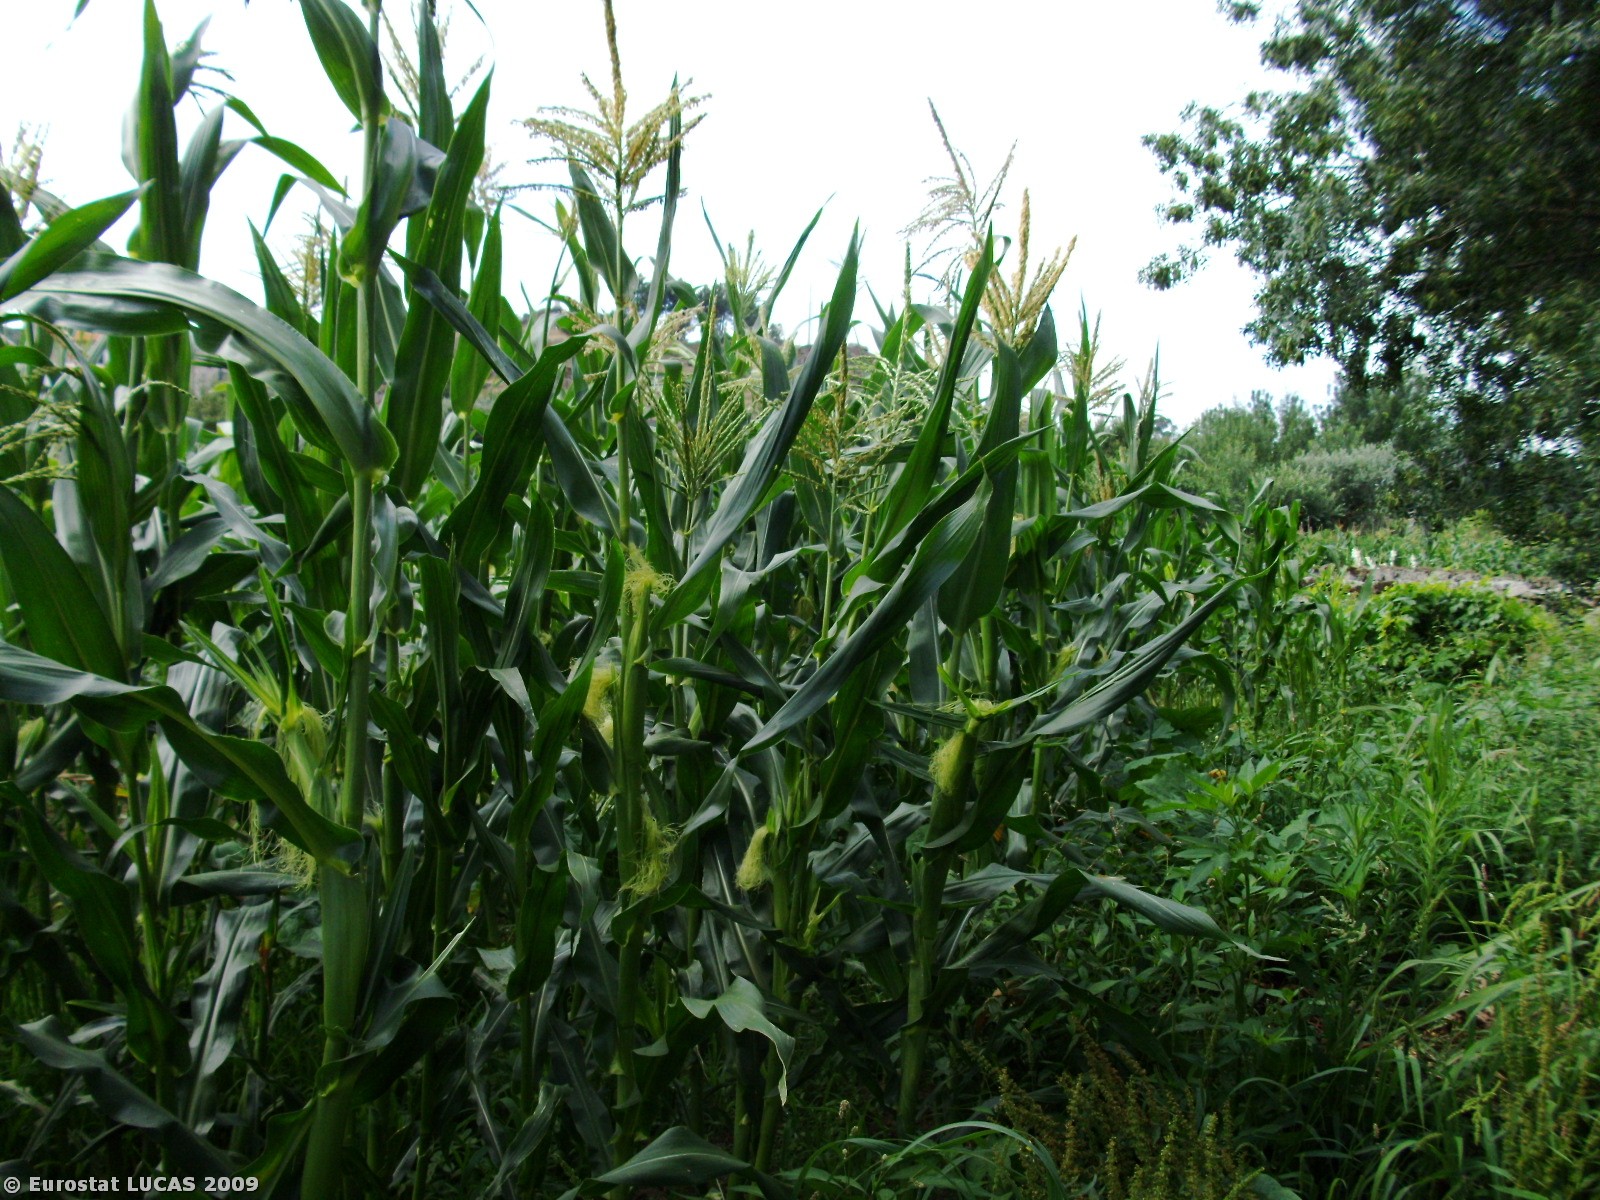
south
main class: Cropland
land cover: Maize
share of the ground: > 75 %
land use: Agriculture (excluding fallow land and kitchen gardens)
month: July
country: PT
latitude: 40.5406
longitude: -7.6244
